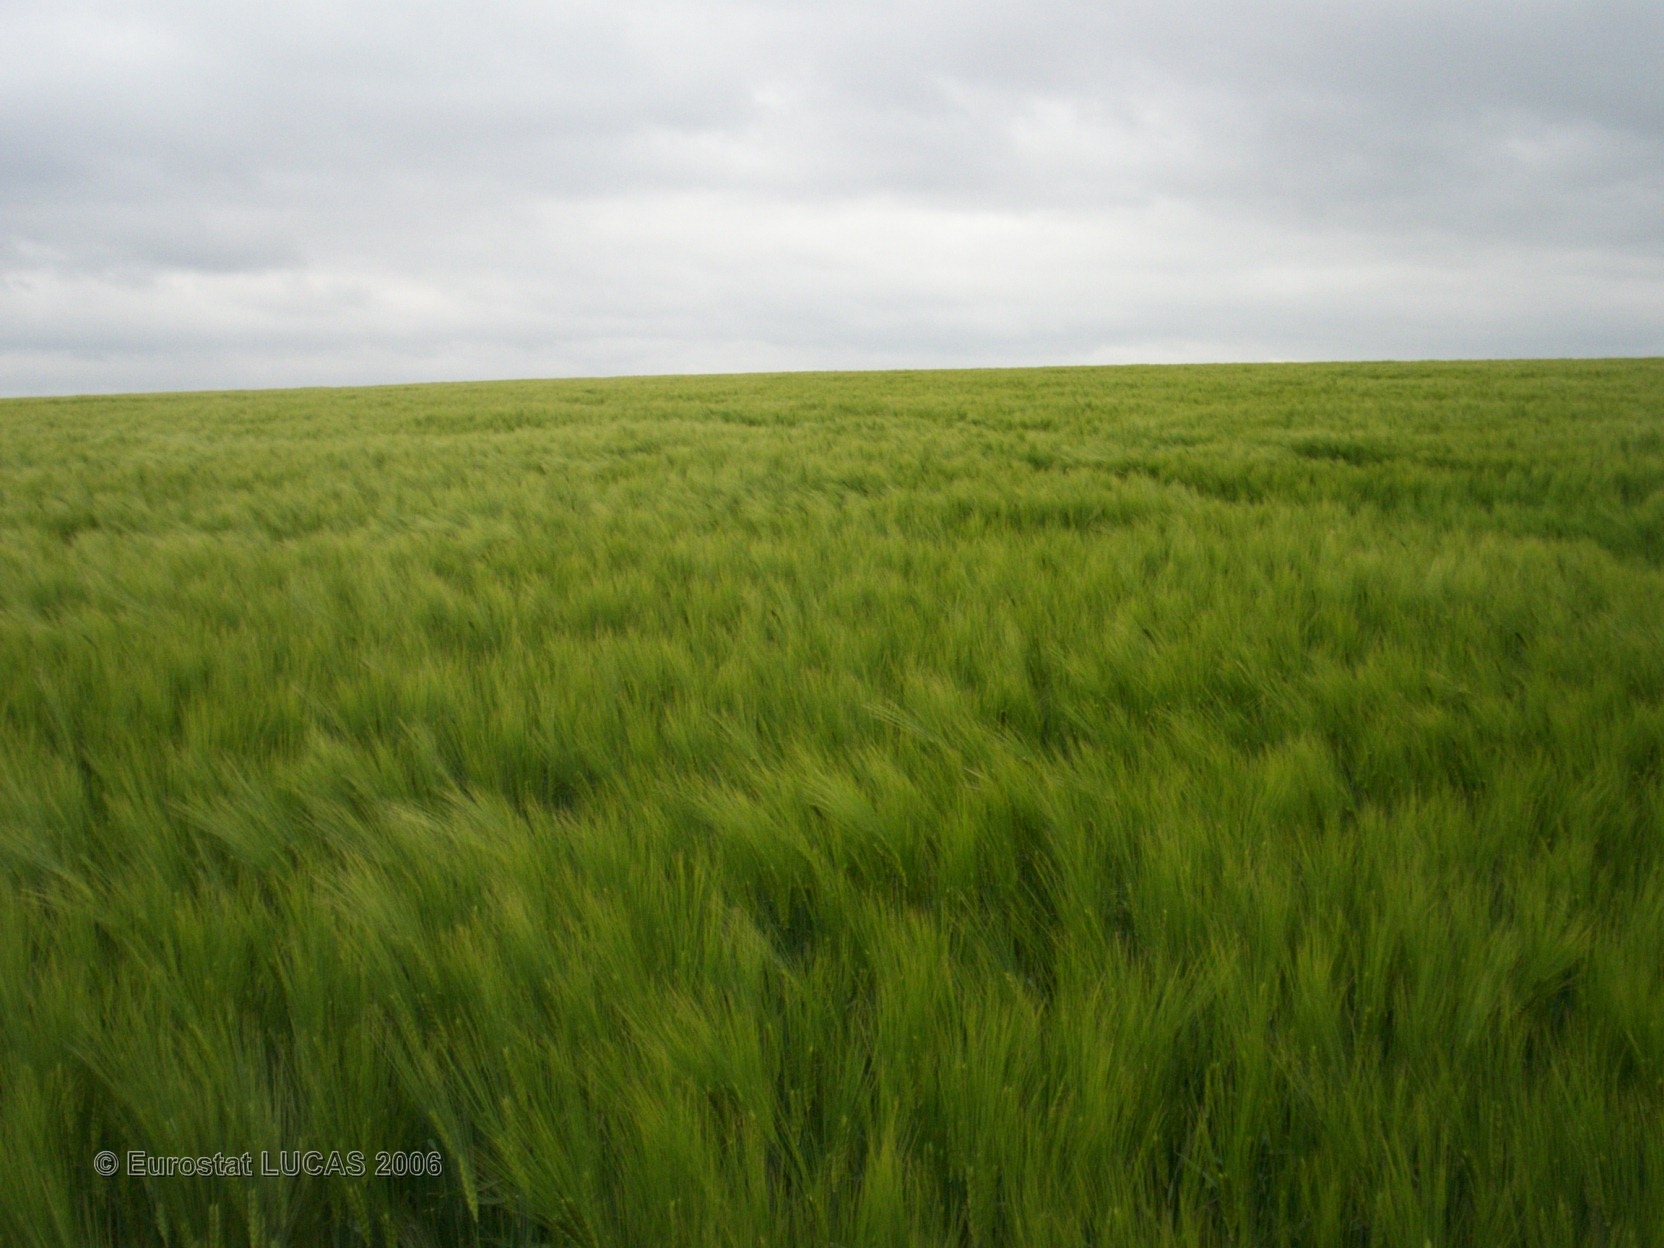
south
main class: Cropland
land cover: Barley
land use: Agriculture (excluding fallow land and kitchen gardens)
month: May
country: FR
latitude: 49.3447
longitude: 4.4216
